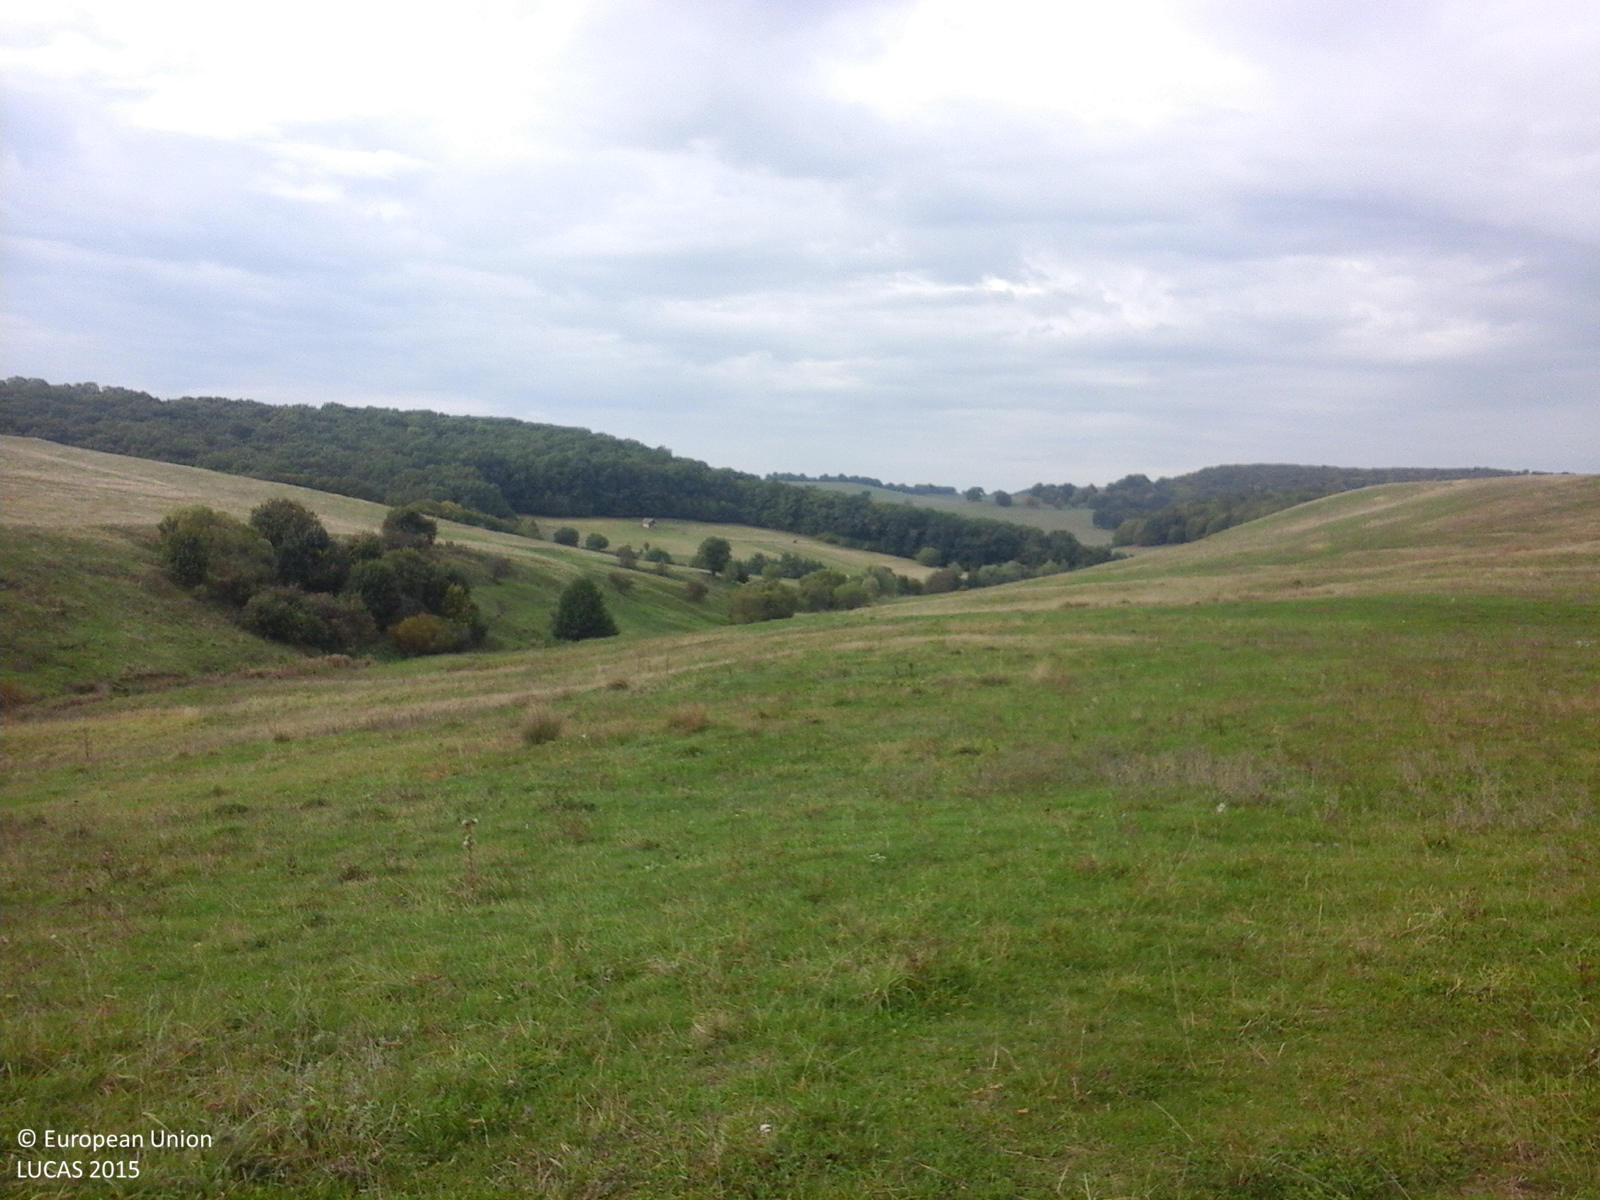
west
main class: Grassland
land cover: Grassland without tree/shrub cover
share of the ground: > 75 %
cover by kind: herbaceous plants 100 %
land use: Agriculture (excluding fallow land and kitchen gardens)
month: October
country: RO
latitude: 46.6581
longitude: 24.8759
